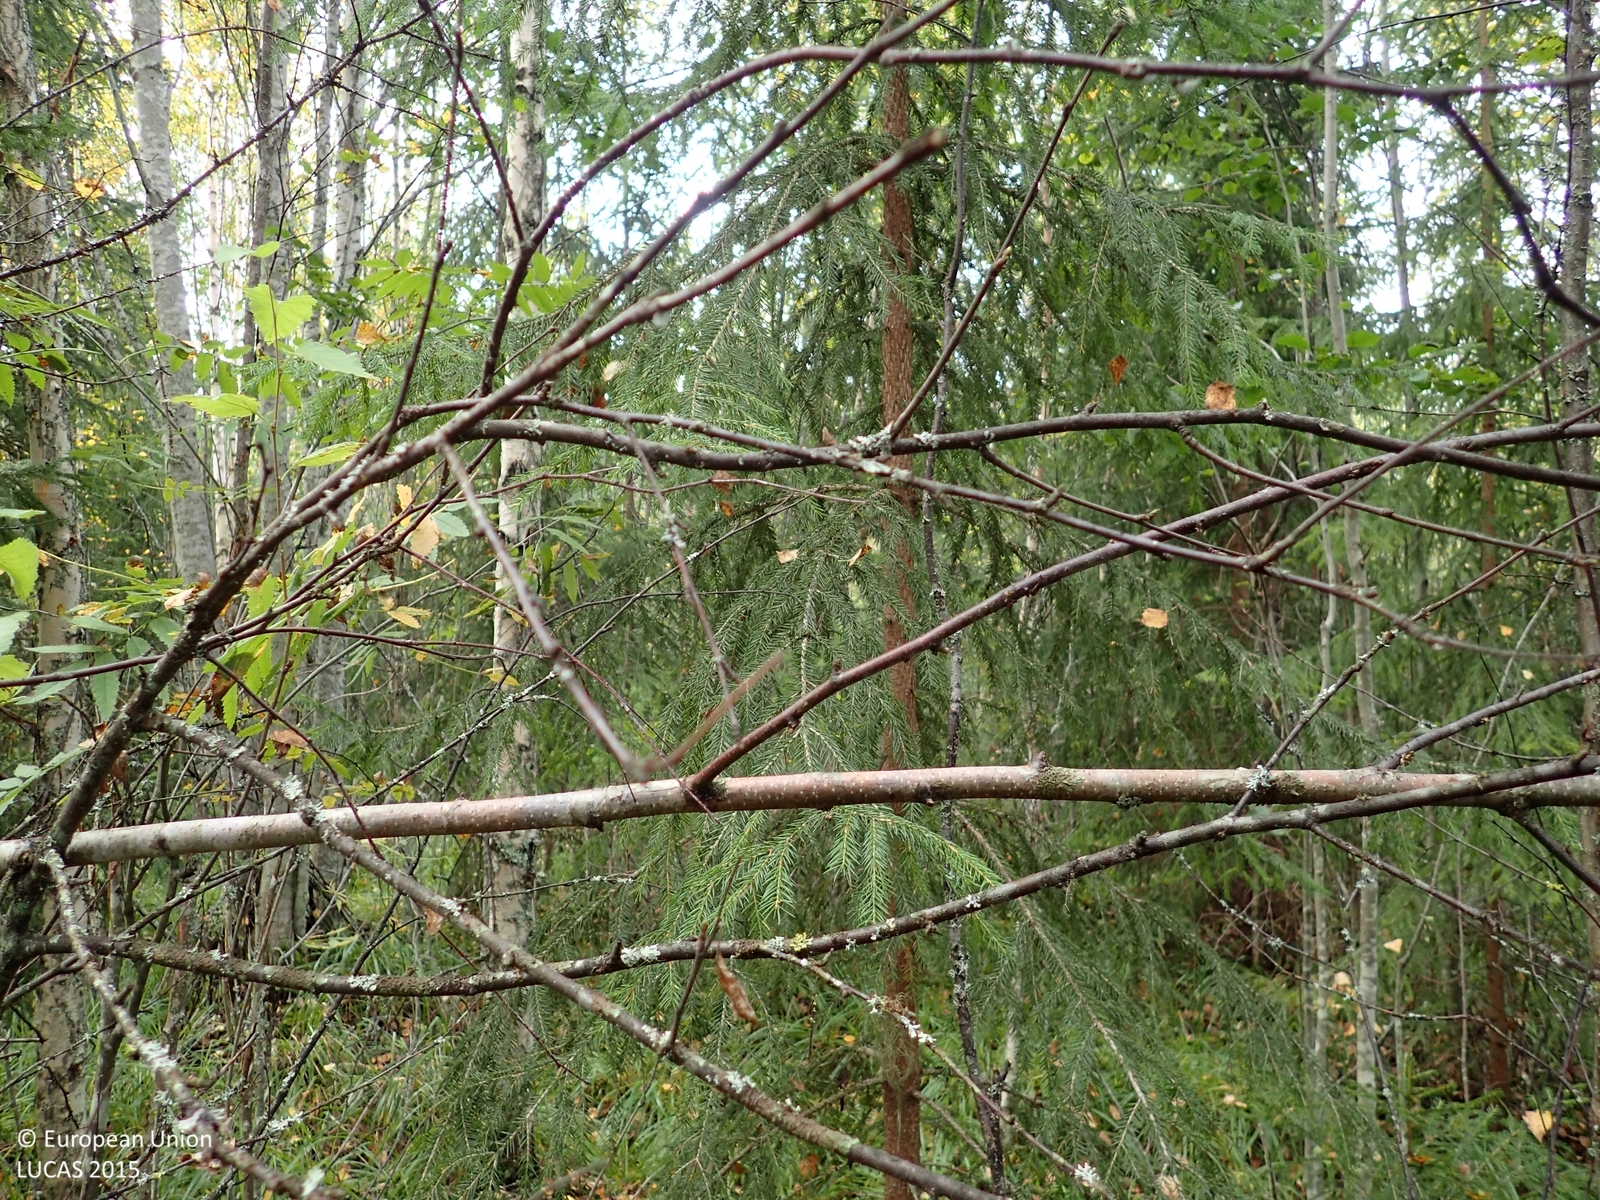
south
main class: Woodland
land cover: Spruce dominated mixed woodland
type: boreal forest
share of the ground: > 75 %
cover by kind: broadleaved forest trees 55 %, coniferous forest trees 30 %, herbaceous plants 10 %, lichens and mosses 5 %
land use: Forestry
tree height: > 5 m
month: September
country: FI
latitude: 63.0772
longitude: 26.0147
